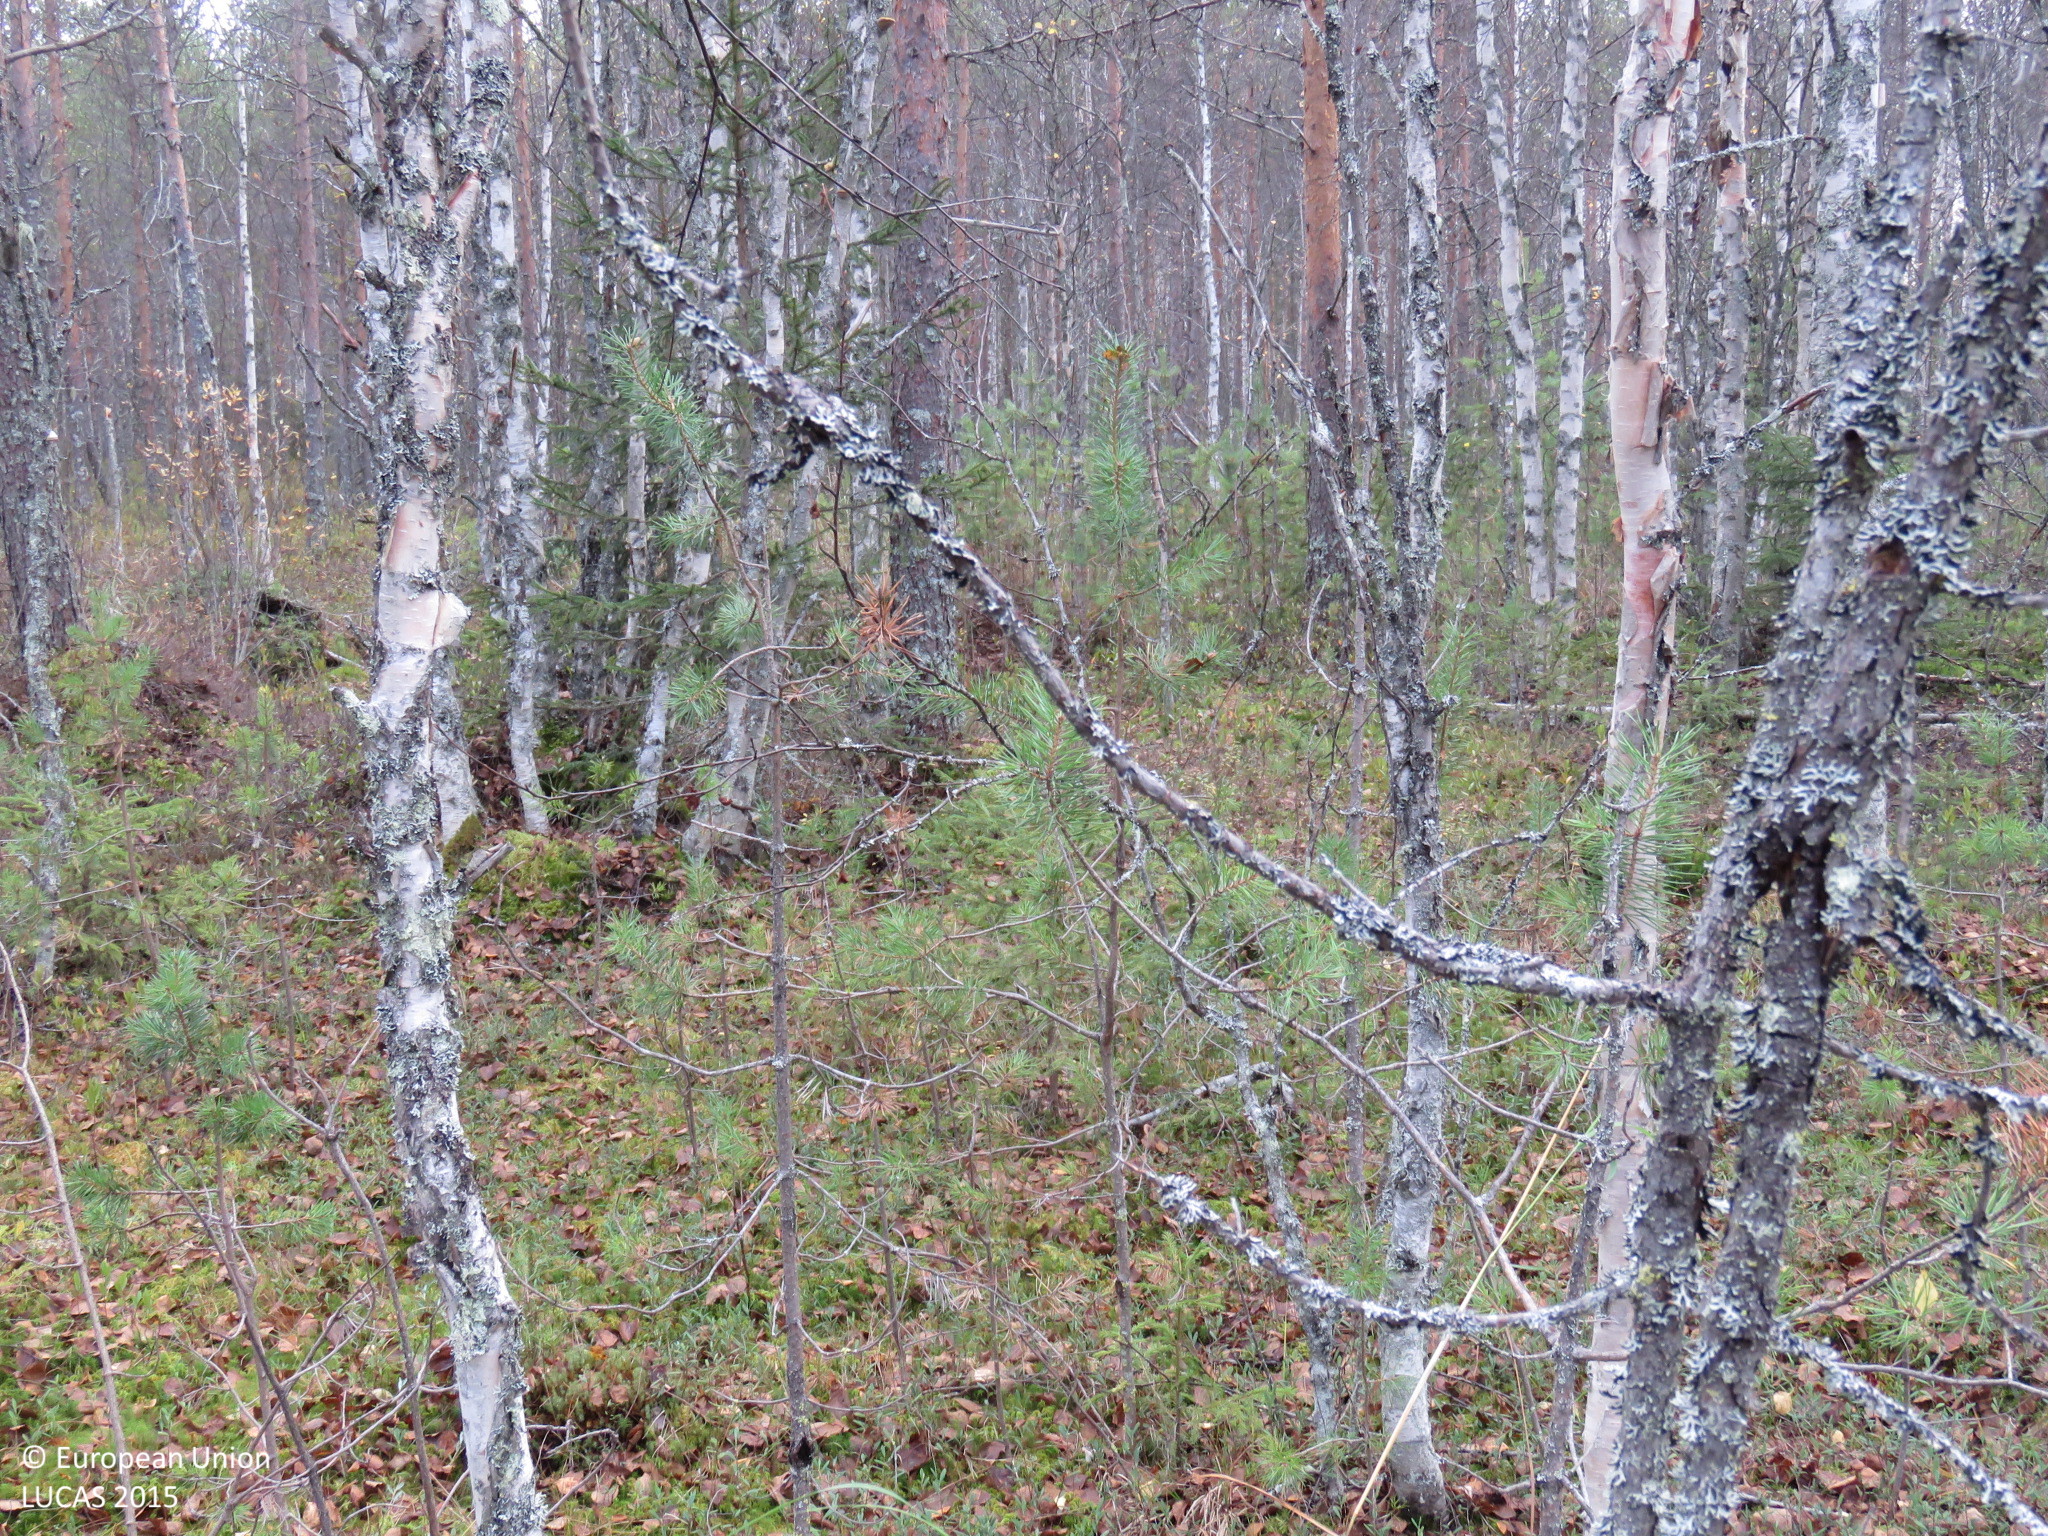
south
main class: Woodland
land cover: Pine dominated mixed woodland
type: mire and swamp forests
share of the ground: > 75 %
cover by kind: broadleaved forest trees 50 %, coniferous forest trees 35 %, shrubs 5 %, herbaceous plants 5 %, lichens and mosses 5 %
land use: Forestry
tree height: > 5 m
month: September
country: FI
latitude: 64.9134
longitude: 27.2304
